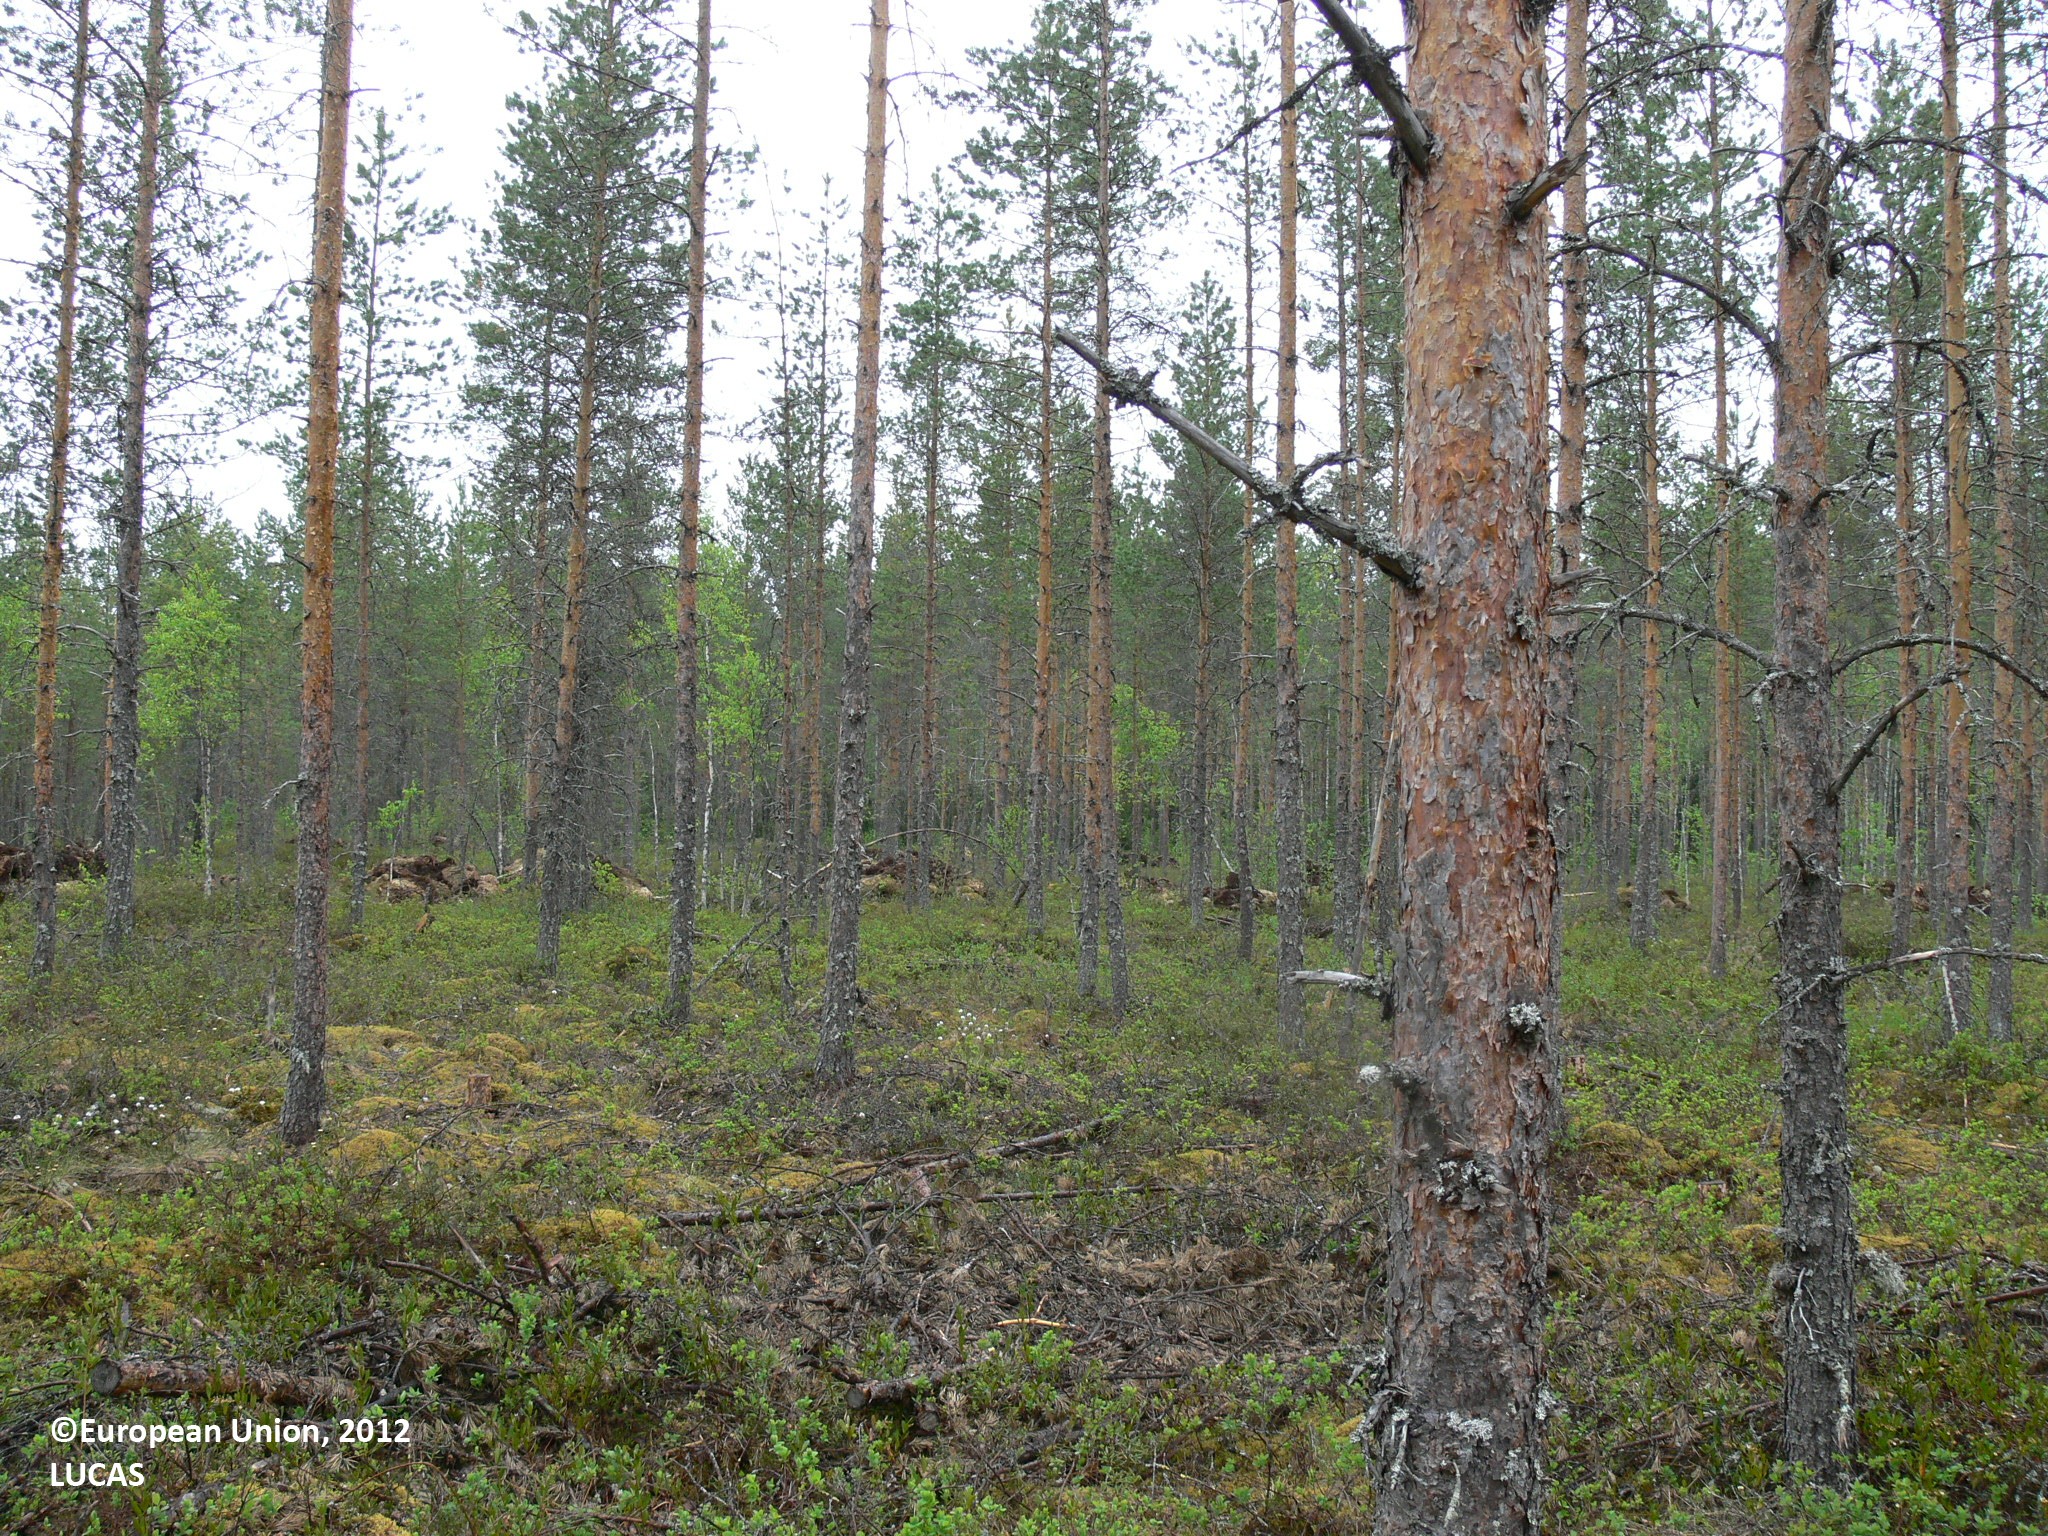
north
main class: Woodland
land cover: Pine dominated coniferous woodland
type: boreal forest
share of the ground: > 75 %
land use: Forestry
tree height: > 5 m
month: June
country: FI
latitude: 62.2268
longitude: 30.2219
